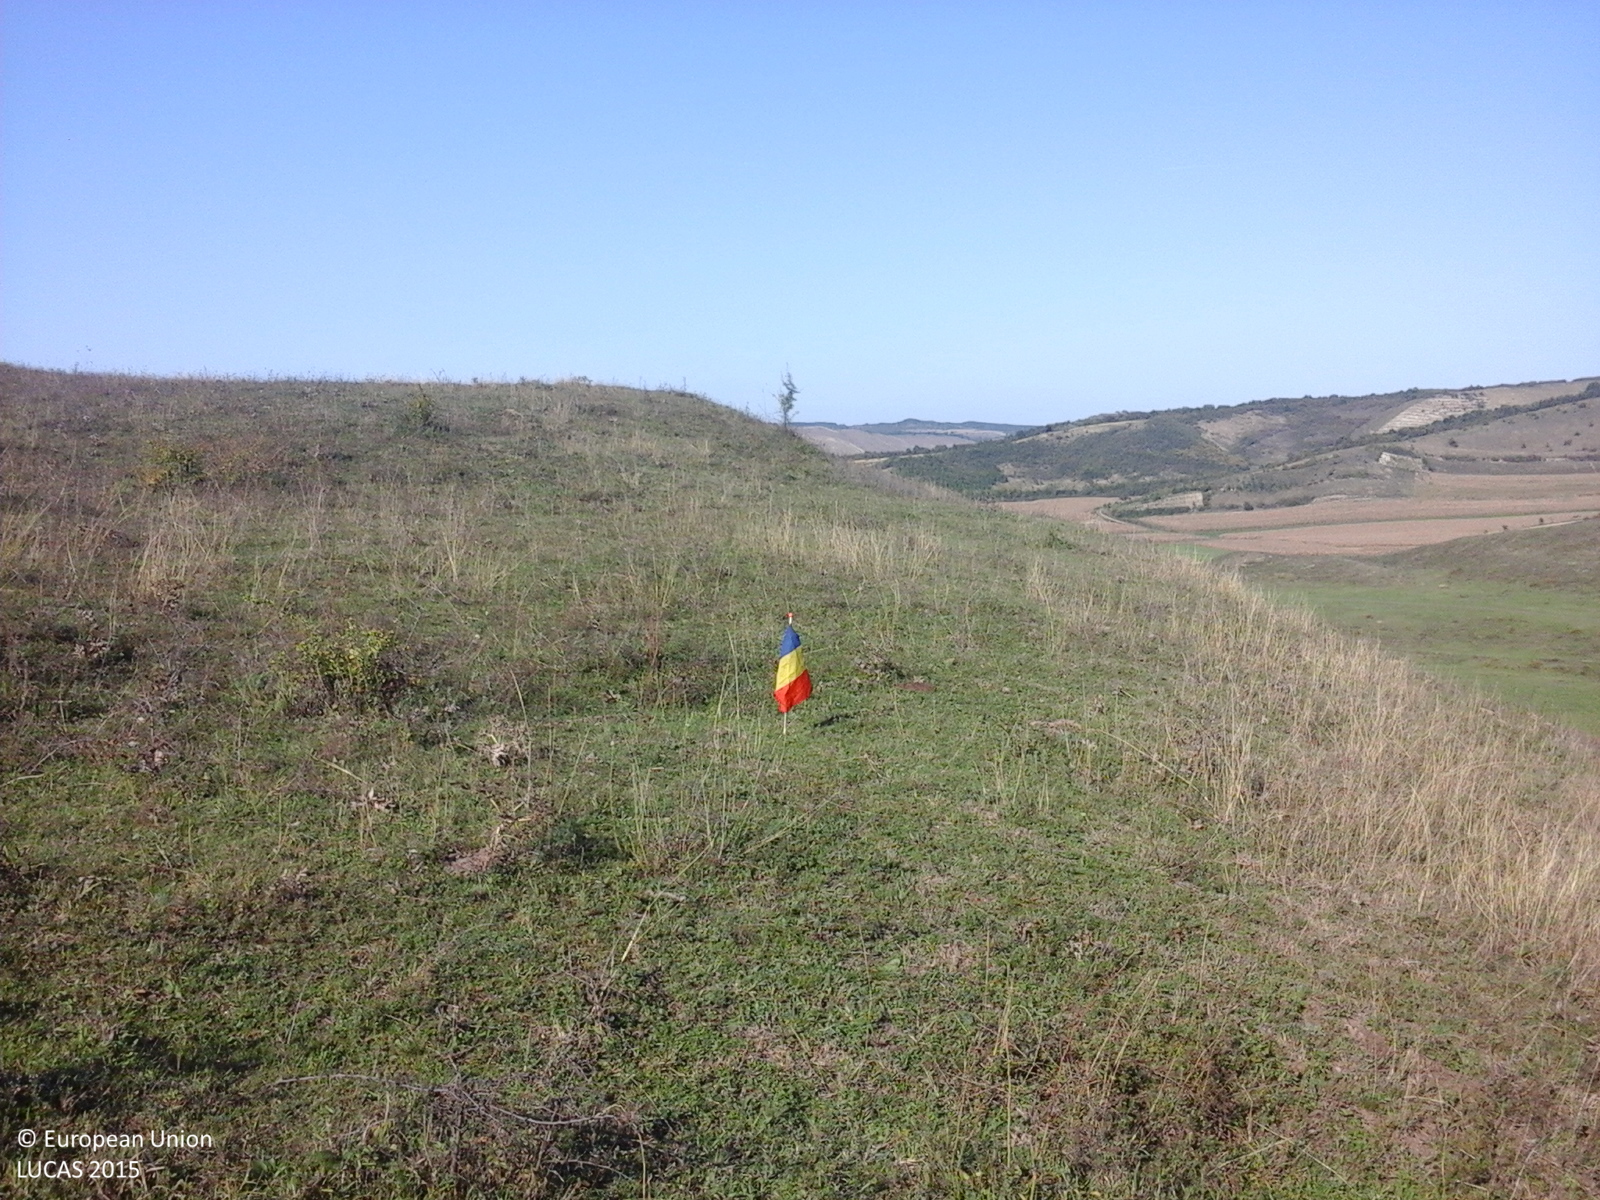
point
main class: Grassland
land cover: Grassland without tree/shrub cover
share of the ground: > 75 %
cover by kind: herbaceous plants 100 %
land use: Agriculture (excluding fallow land and kitchen gardens)
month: October
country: RO
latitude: 46.2859
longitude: 23.8437
